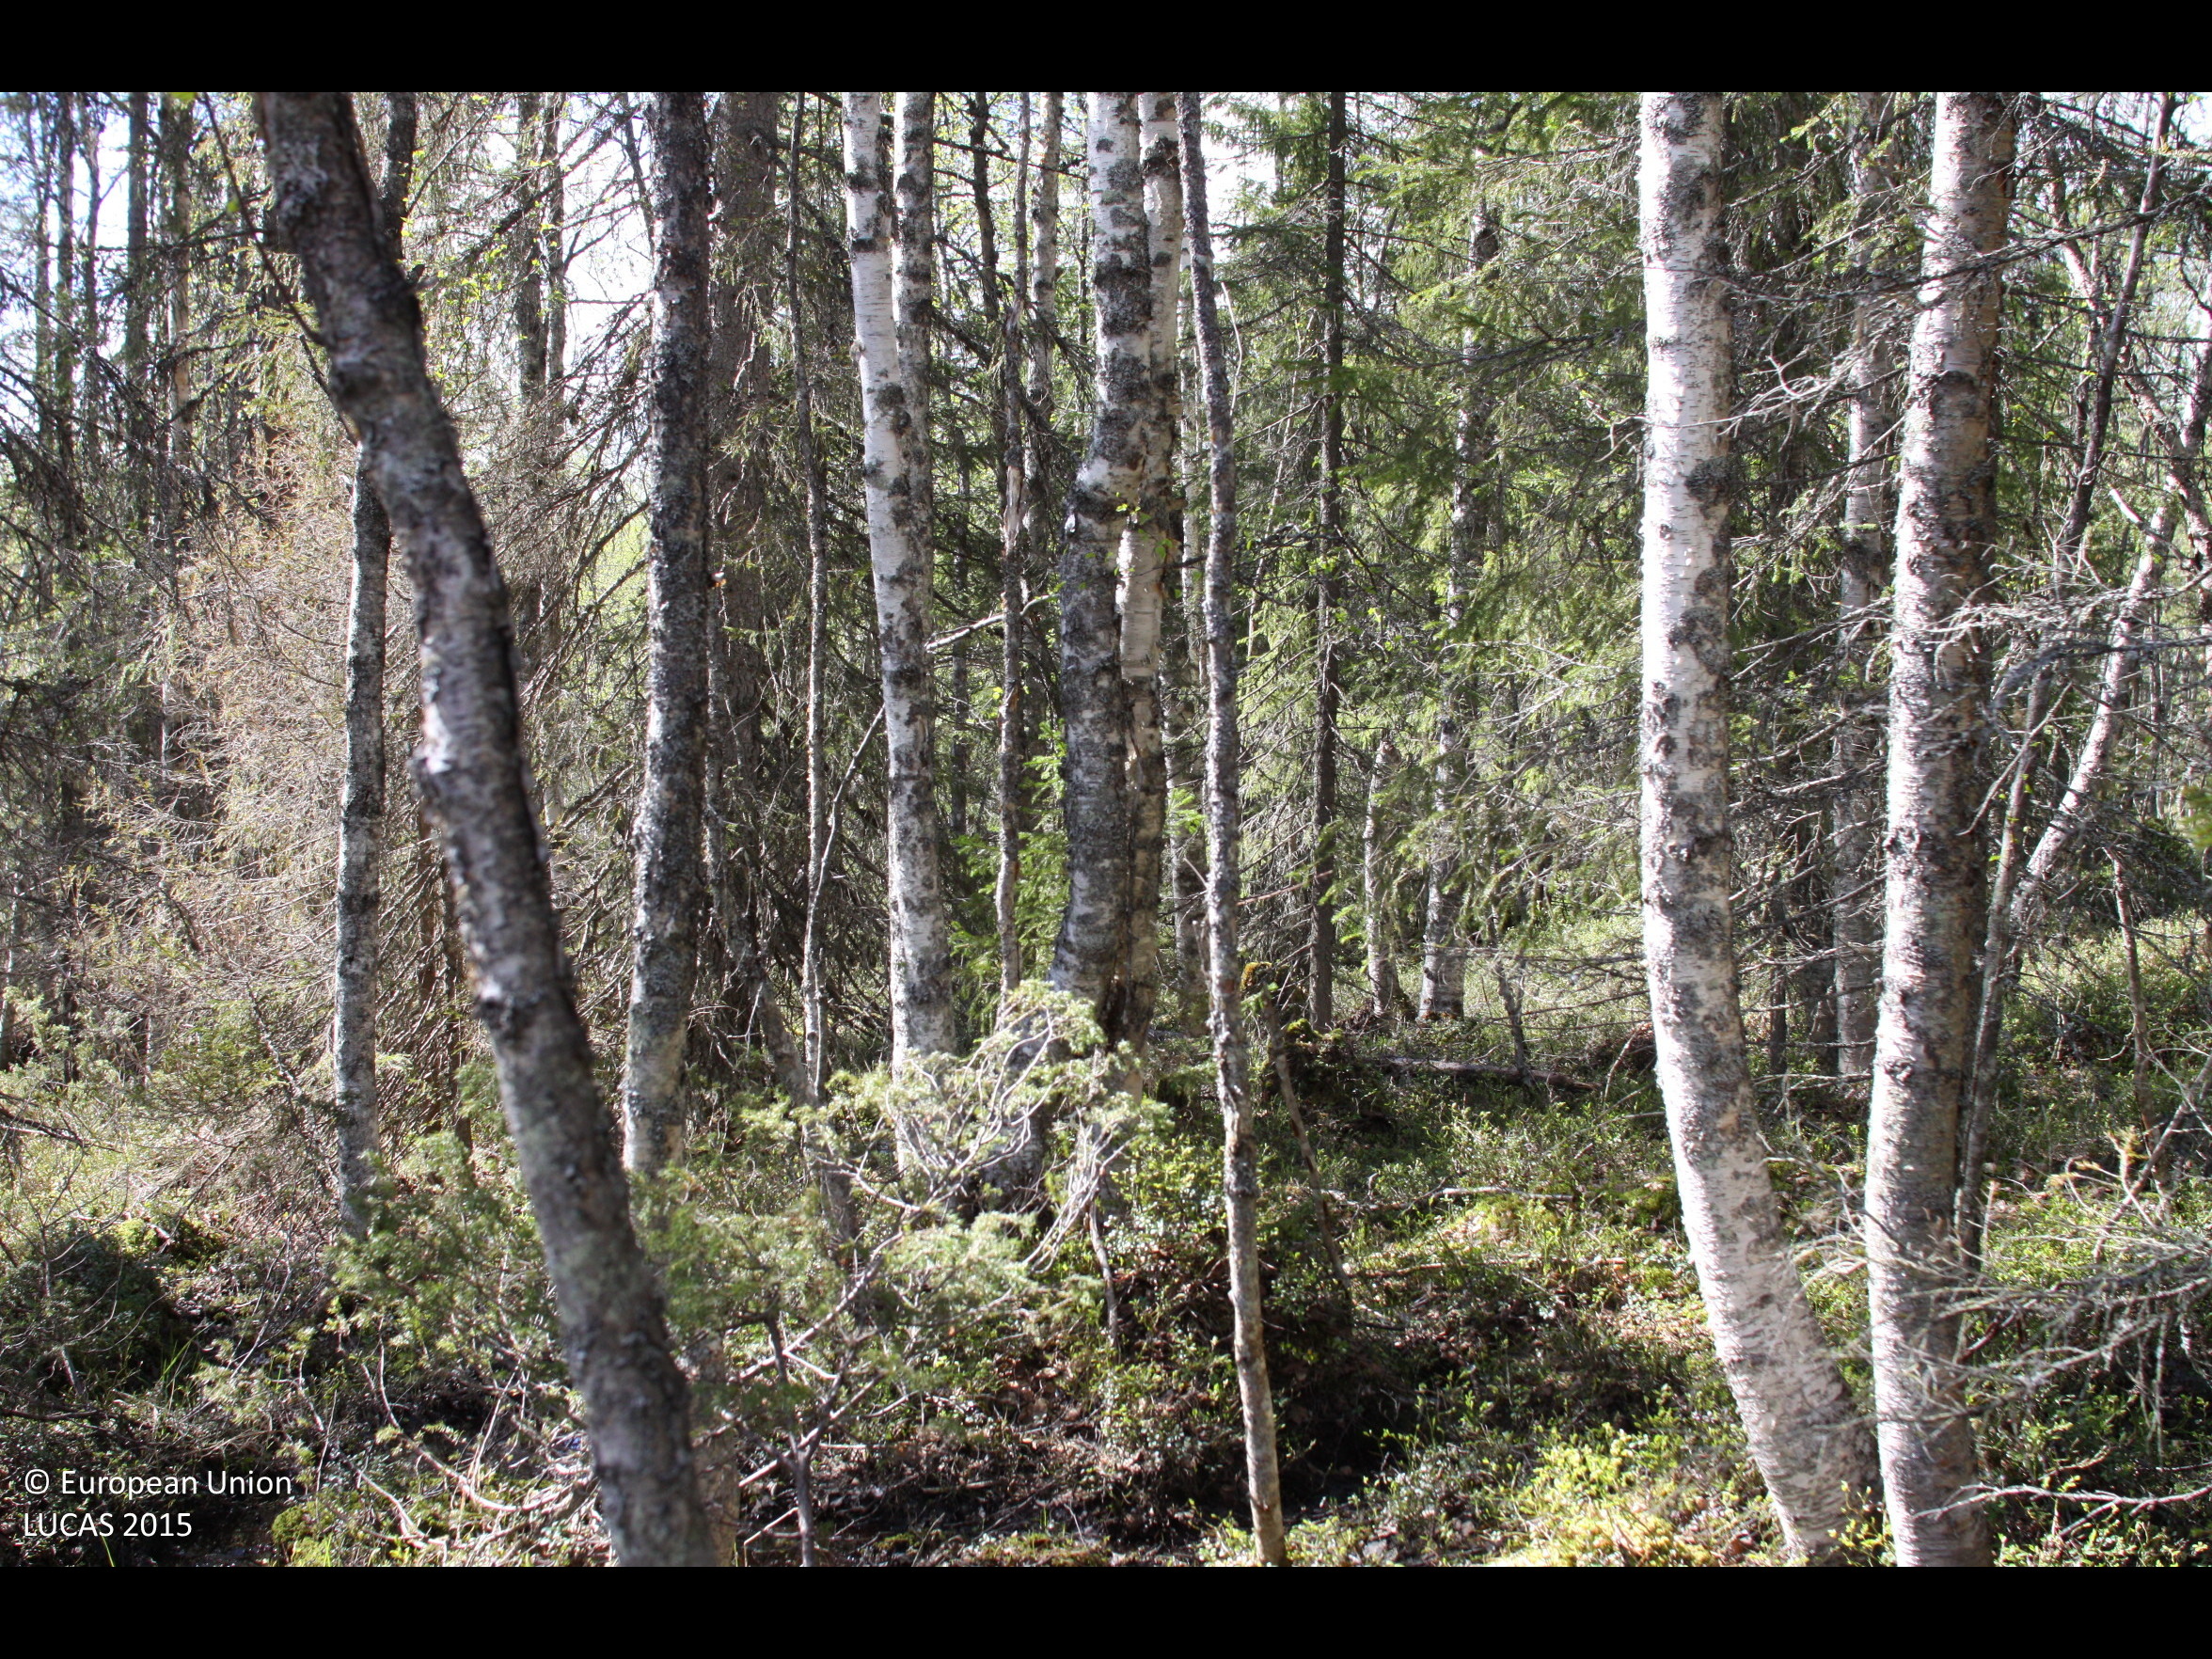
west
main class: Woodland
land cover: Spruce dominated mixed woodland
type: boreal forest
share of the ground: > 75 %
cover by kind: coniferous forest trees 40 %, broadleaved forest trees 40 %, shrubs 20 %
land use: Forestry
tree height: > 5 m
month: June
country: FI
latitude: 66.2062
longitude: 27.6949
